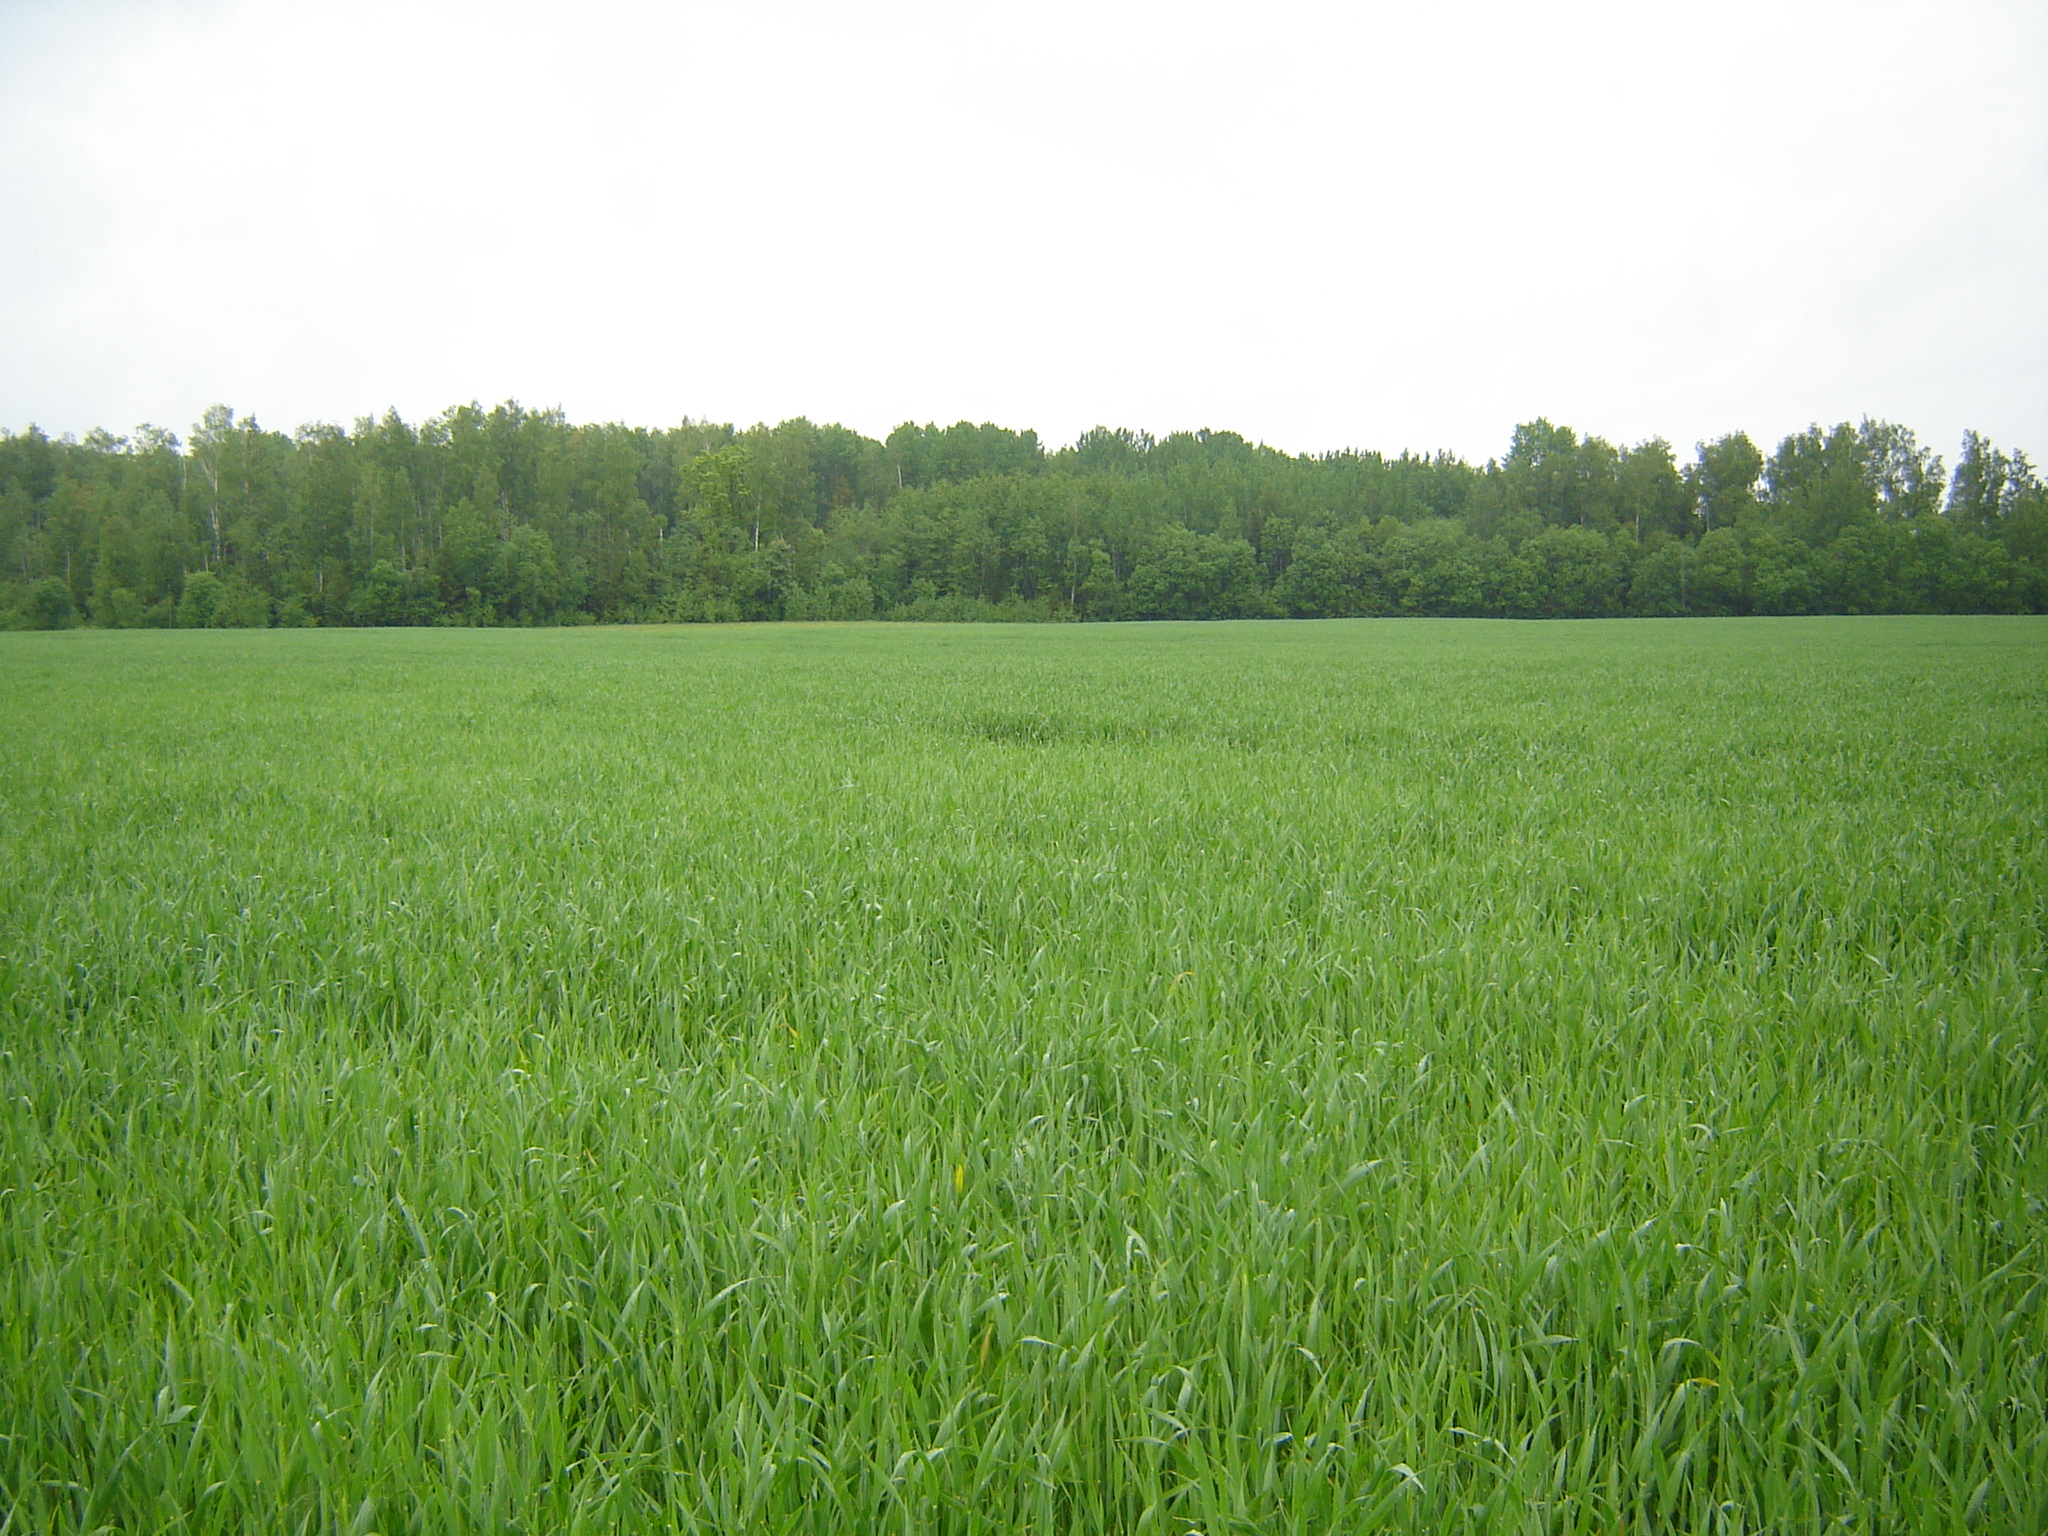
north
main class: Cropland
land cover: Common wheat
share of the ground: > 75 %
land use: Agriculture (excluding fallow land and kitchen gardens)
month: May
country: LT
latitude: 55.9296
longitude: 25.2414
